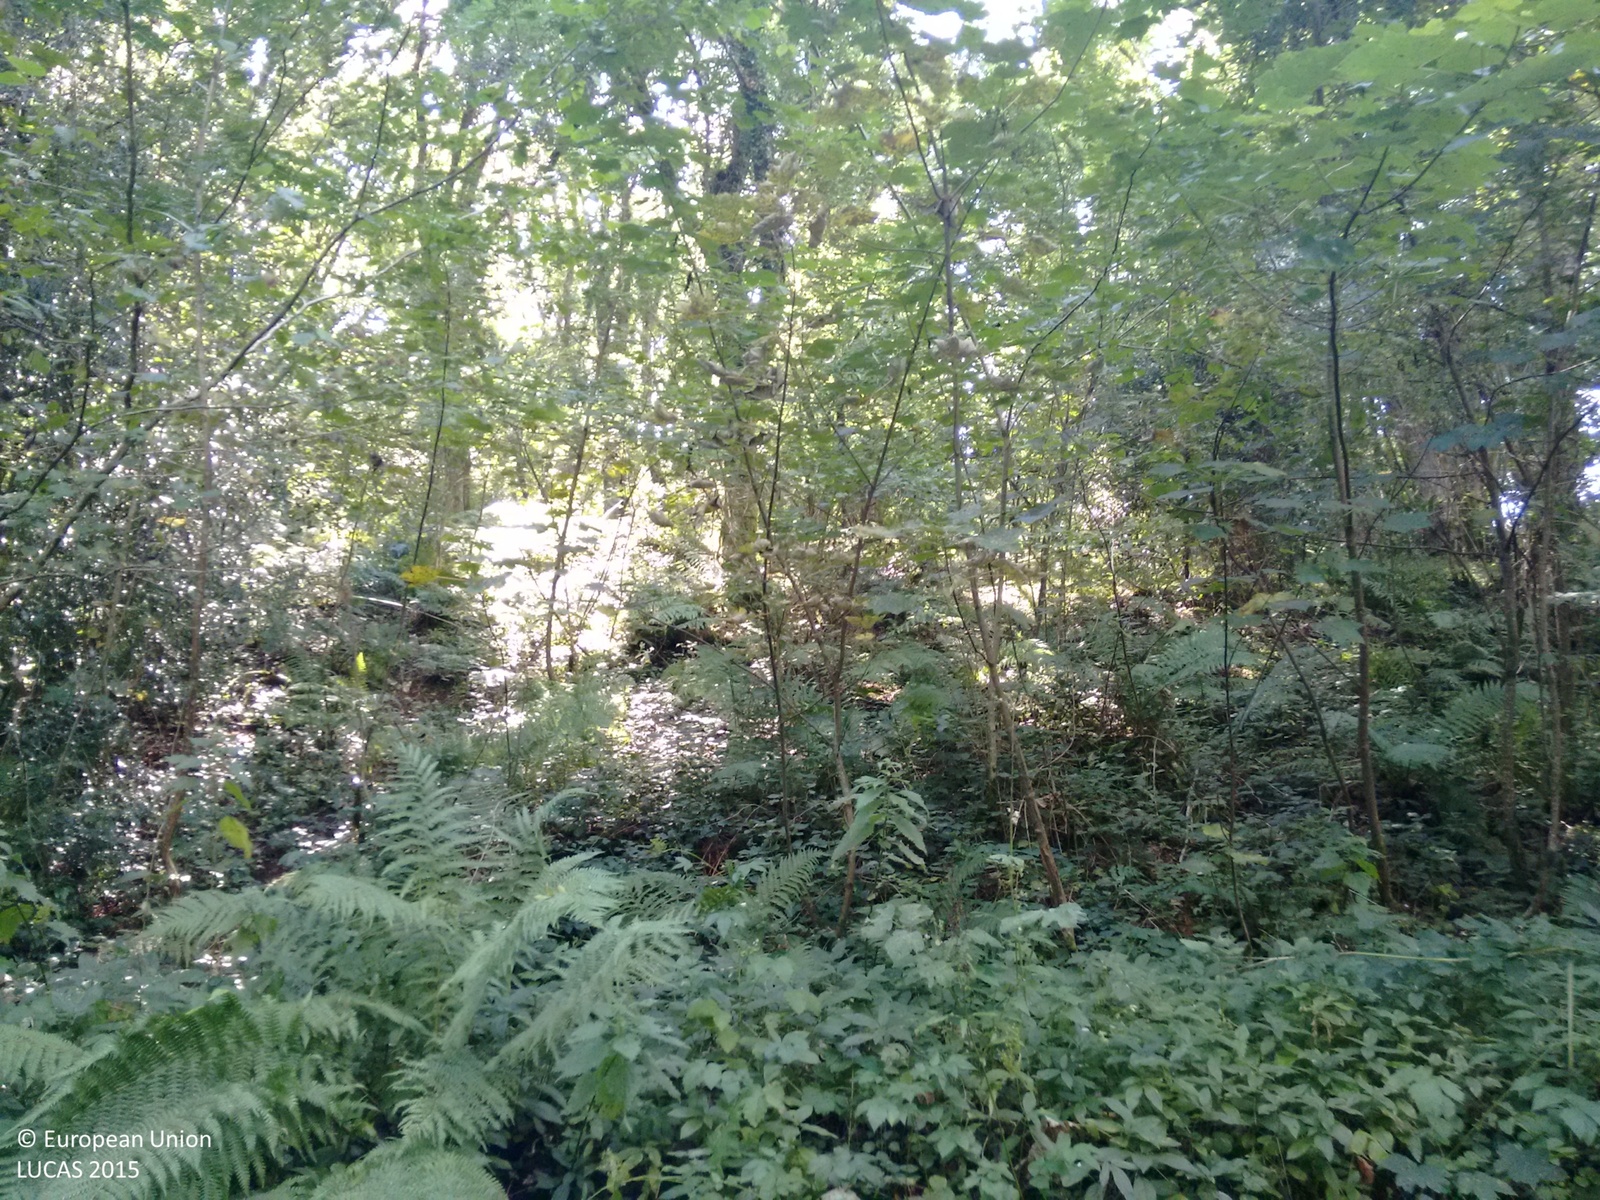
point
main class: Woodland
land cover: Broadleaved woodland
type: beech forest
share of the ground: > 75 %
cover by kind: broadleaved forest trees 100 %
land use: Semi-natural and natural areas not in use
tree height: > 5 m
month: September
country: GB
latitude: 50.9502
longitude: -3.9141
